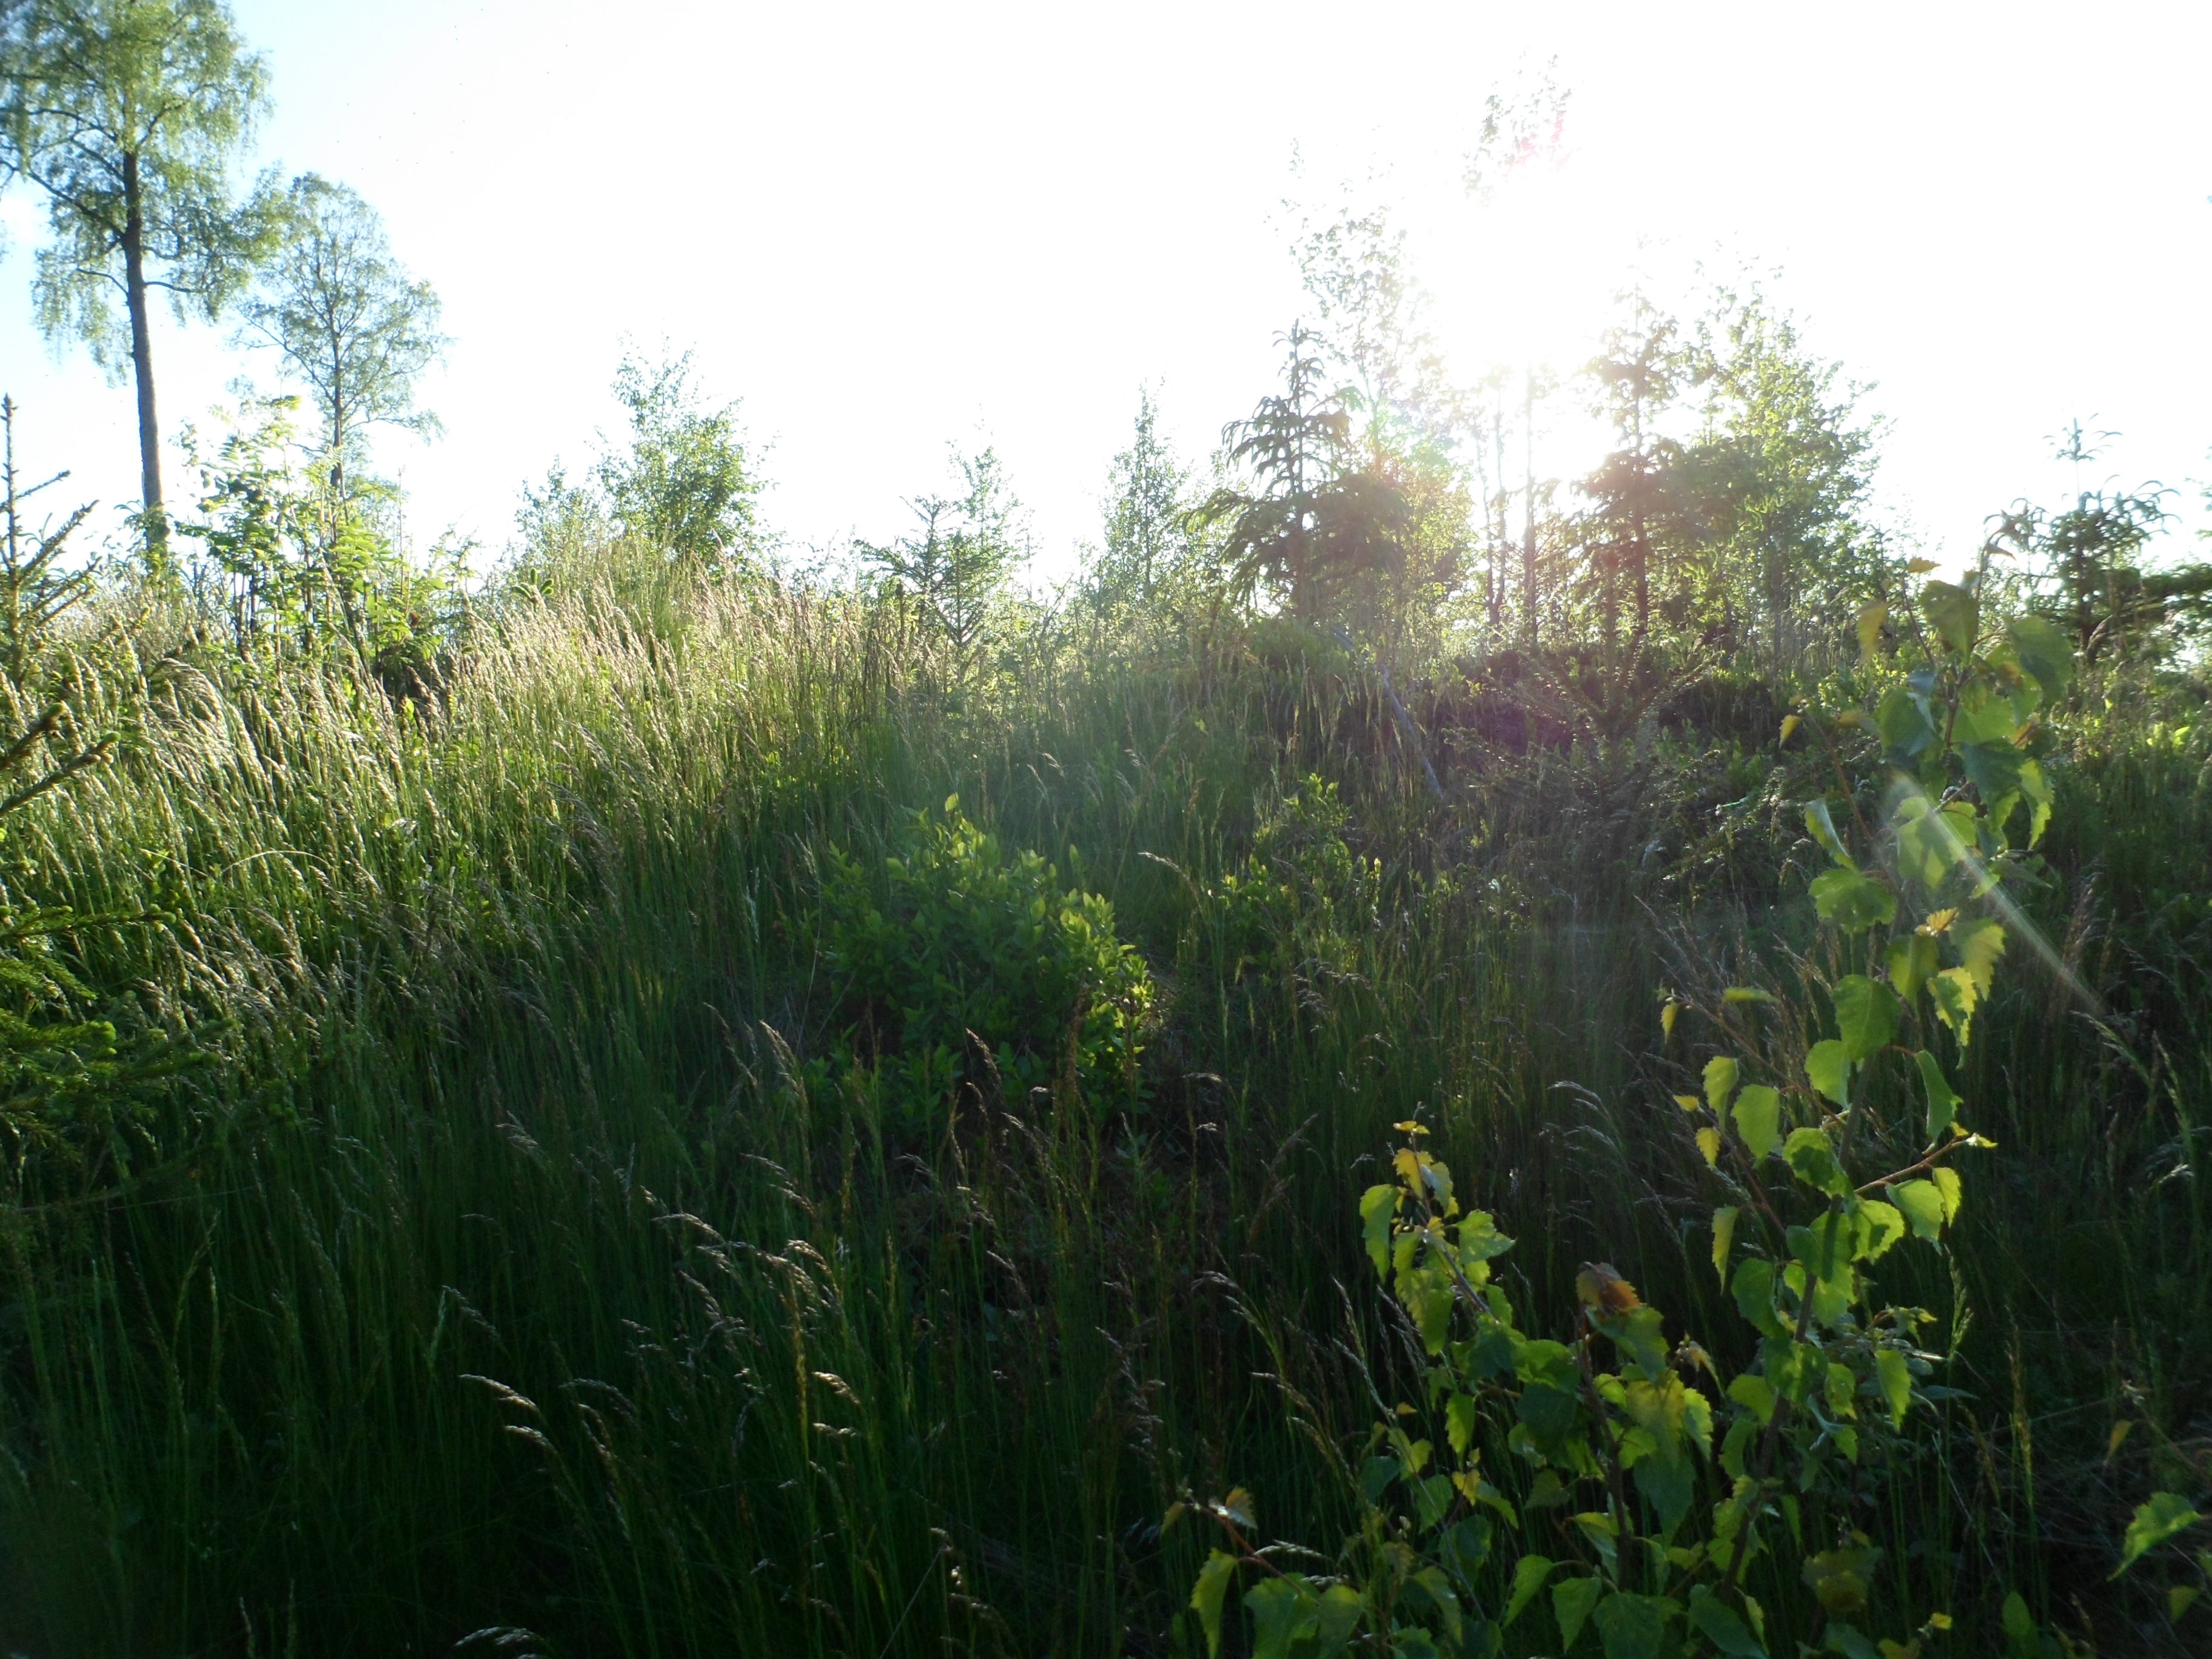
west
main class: Woodland
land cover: Spruce dominated mixed woodland
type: boreal forest
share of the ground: 50 - 75 %
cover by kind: coniferous forest trees 25 %, broadleaved forest trees 25 %, herbaceous plants 25 %, shrubs 20 %, lichens and mosses 5 %
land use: Forestry
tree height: < 5 m
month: June
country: SE
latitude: 57.4701
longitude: 14.1806
